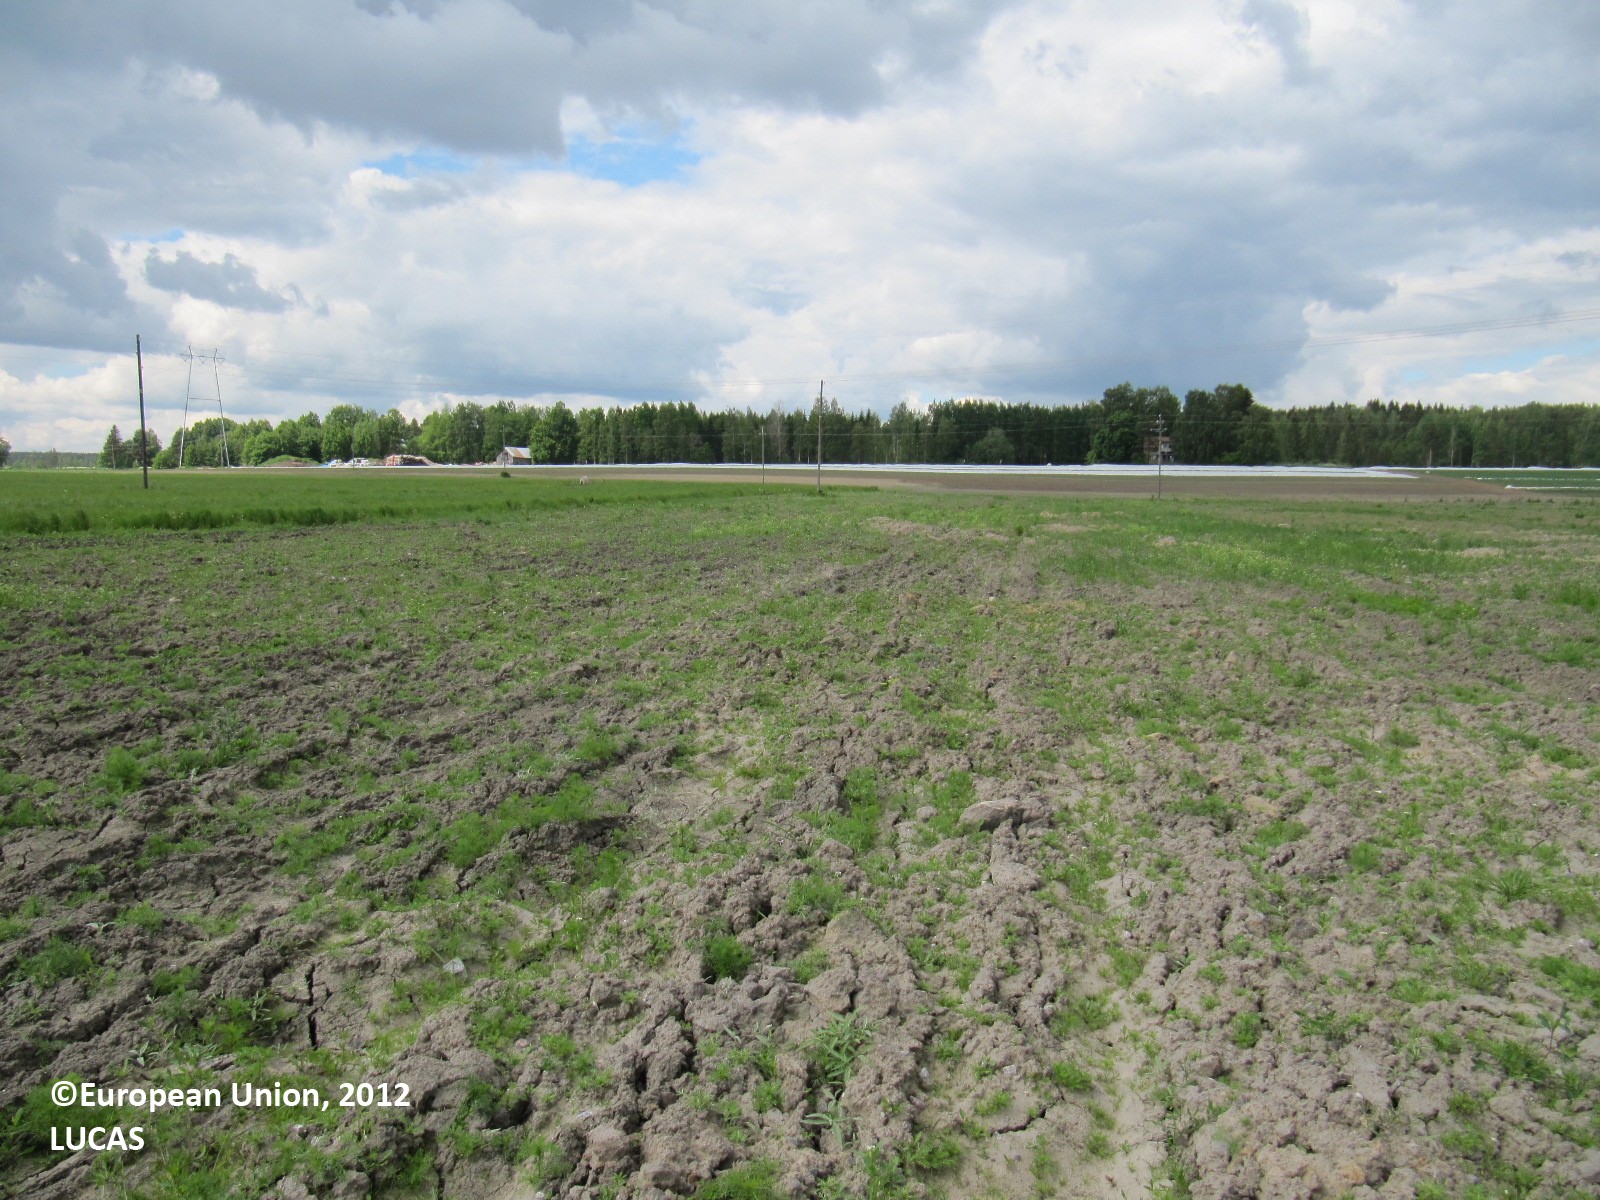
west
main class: Cropland
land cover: Other non-permanent industrial crops
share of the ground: 25 - 50 %
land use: Fallow land
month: June
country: FI
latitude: 60.3567
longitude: 24.3695
